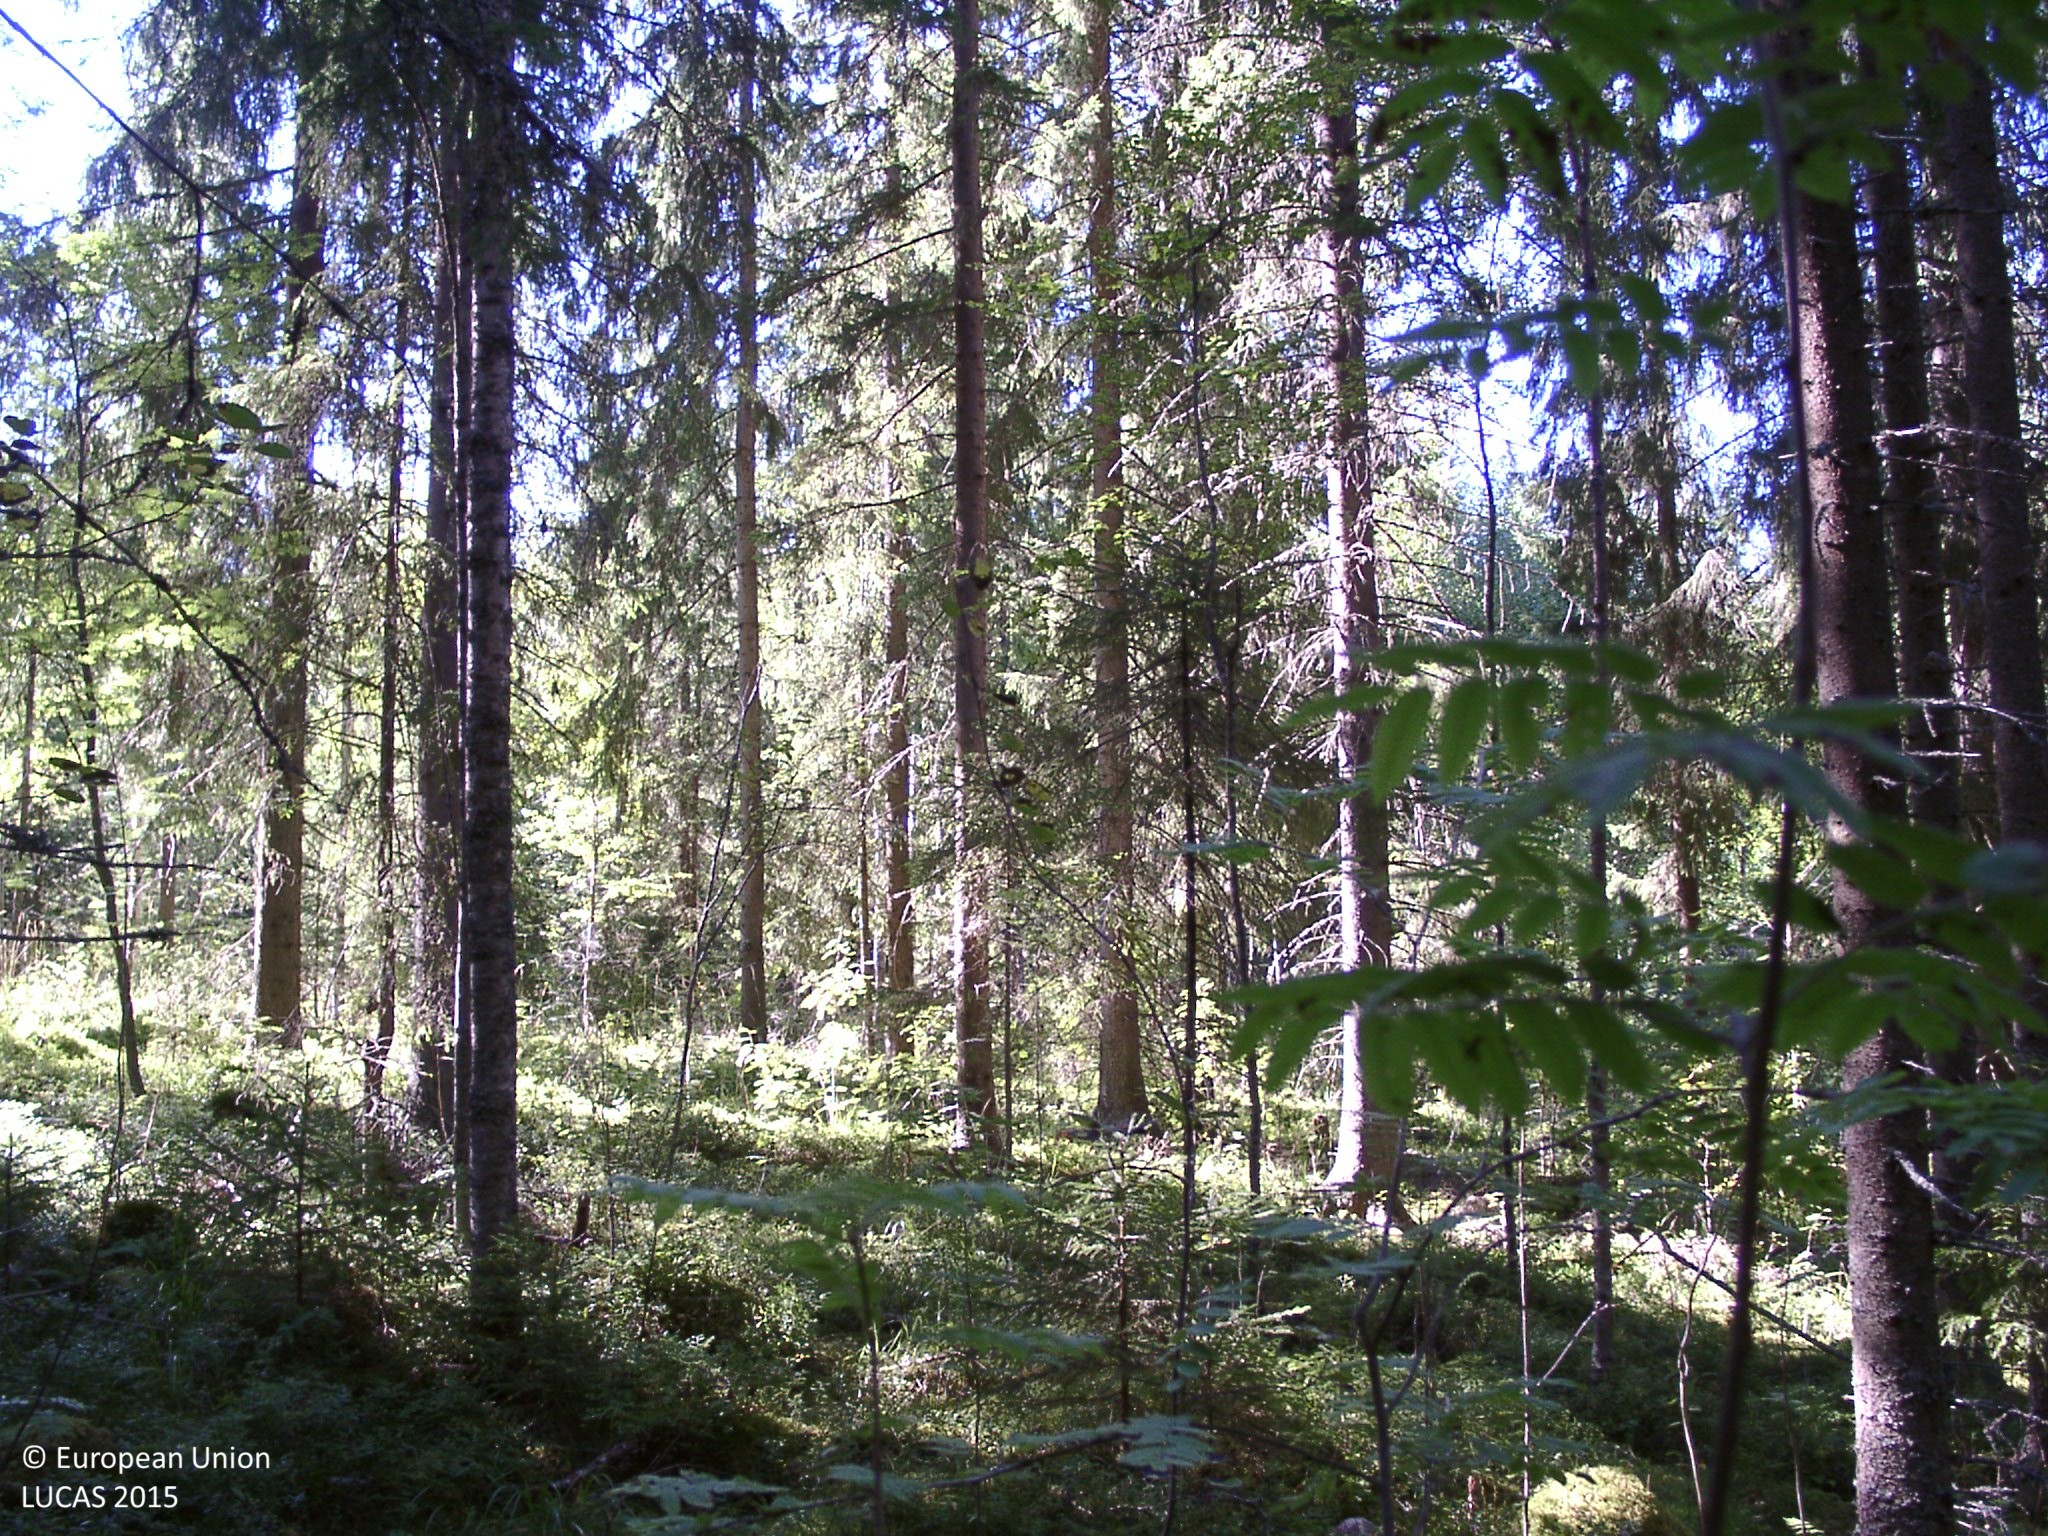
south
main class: Woodland
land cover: Spruce dominated coniferous woodland
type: boreal forest
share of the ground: > 75 %
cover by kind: coniferous forest trees 70 %, shrubs 15 %, lichens and mosses 10 %, broadleaved forest trees 5 %
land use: Forestry
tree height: > 5 m
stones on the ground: < 10 %
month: August
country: FI
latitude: 61.9265
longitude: 25.3716
